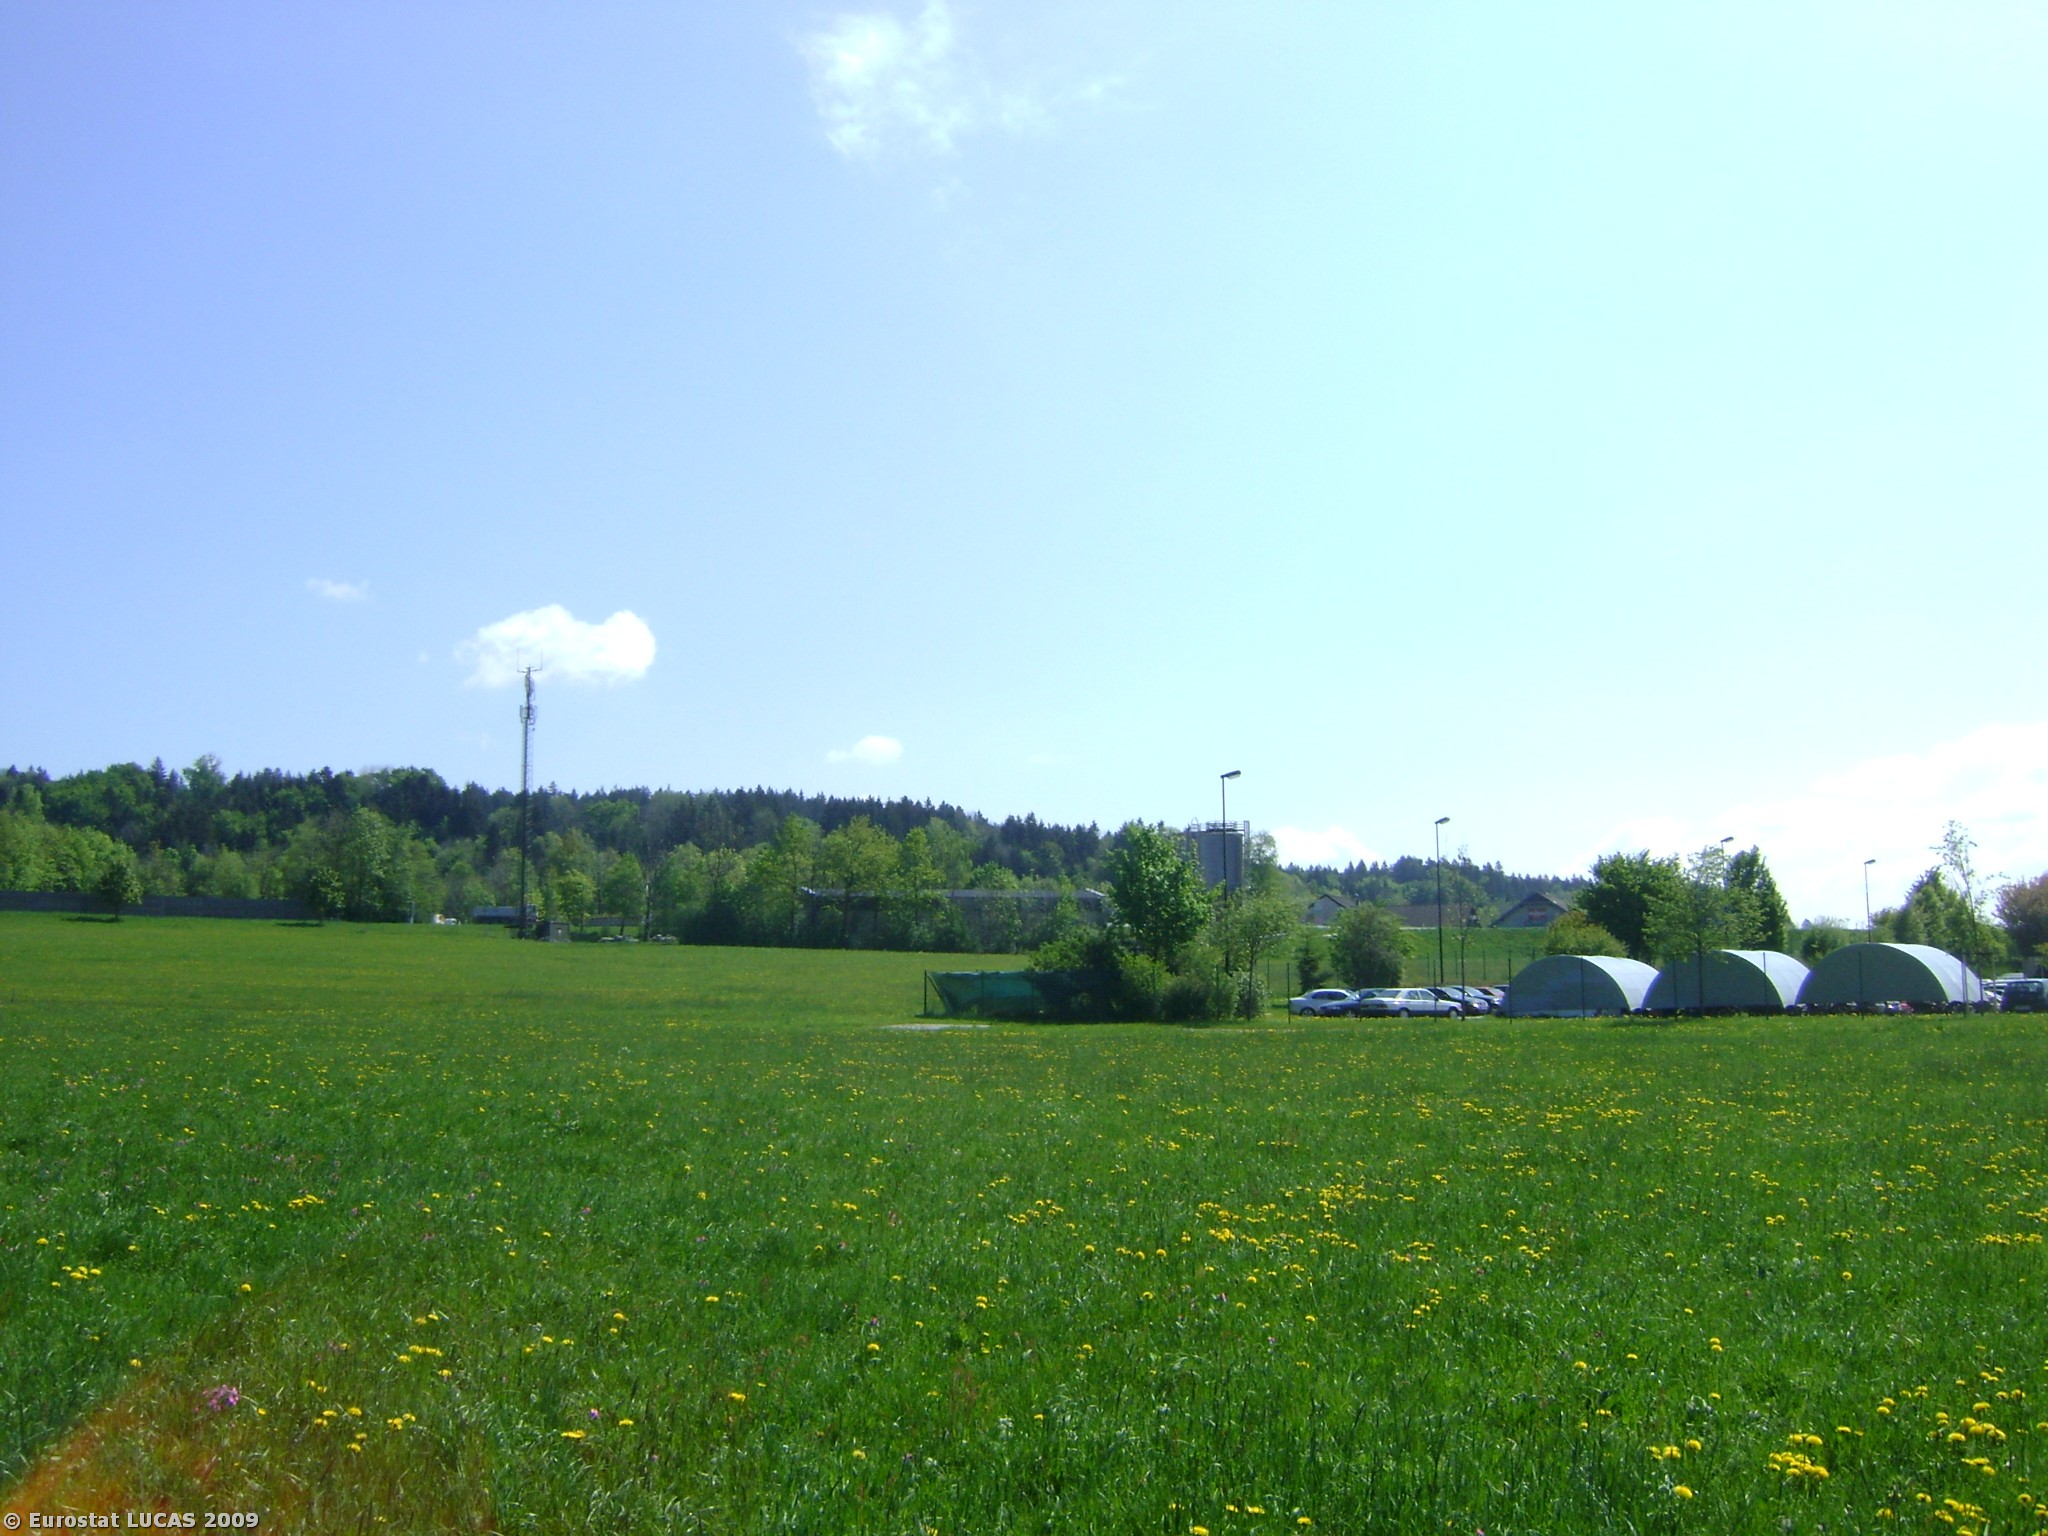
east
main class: Grassland
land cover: Grassland without tree/shrub cover
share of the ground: > 75 %
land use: Agriculture (excluding fallow land and kitchen gardens)
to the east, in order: Grassland without tree/shrub cover; Paved roads, cycling and walking lanes; Grass margins; Fences; Artificial constructions in urban areas; Fences; Grassland without tree/shrub cover
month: May
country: AT
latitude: 47.8524
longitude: 13.2196
